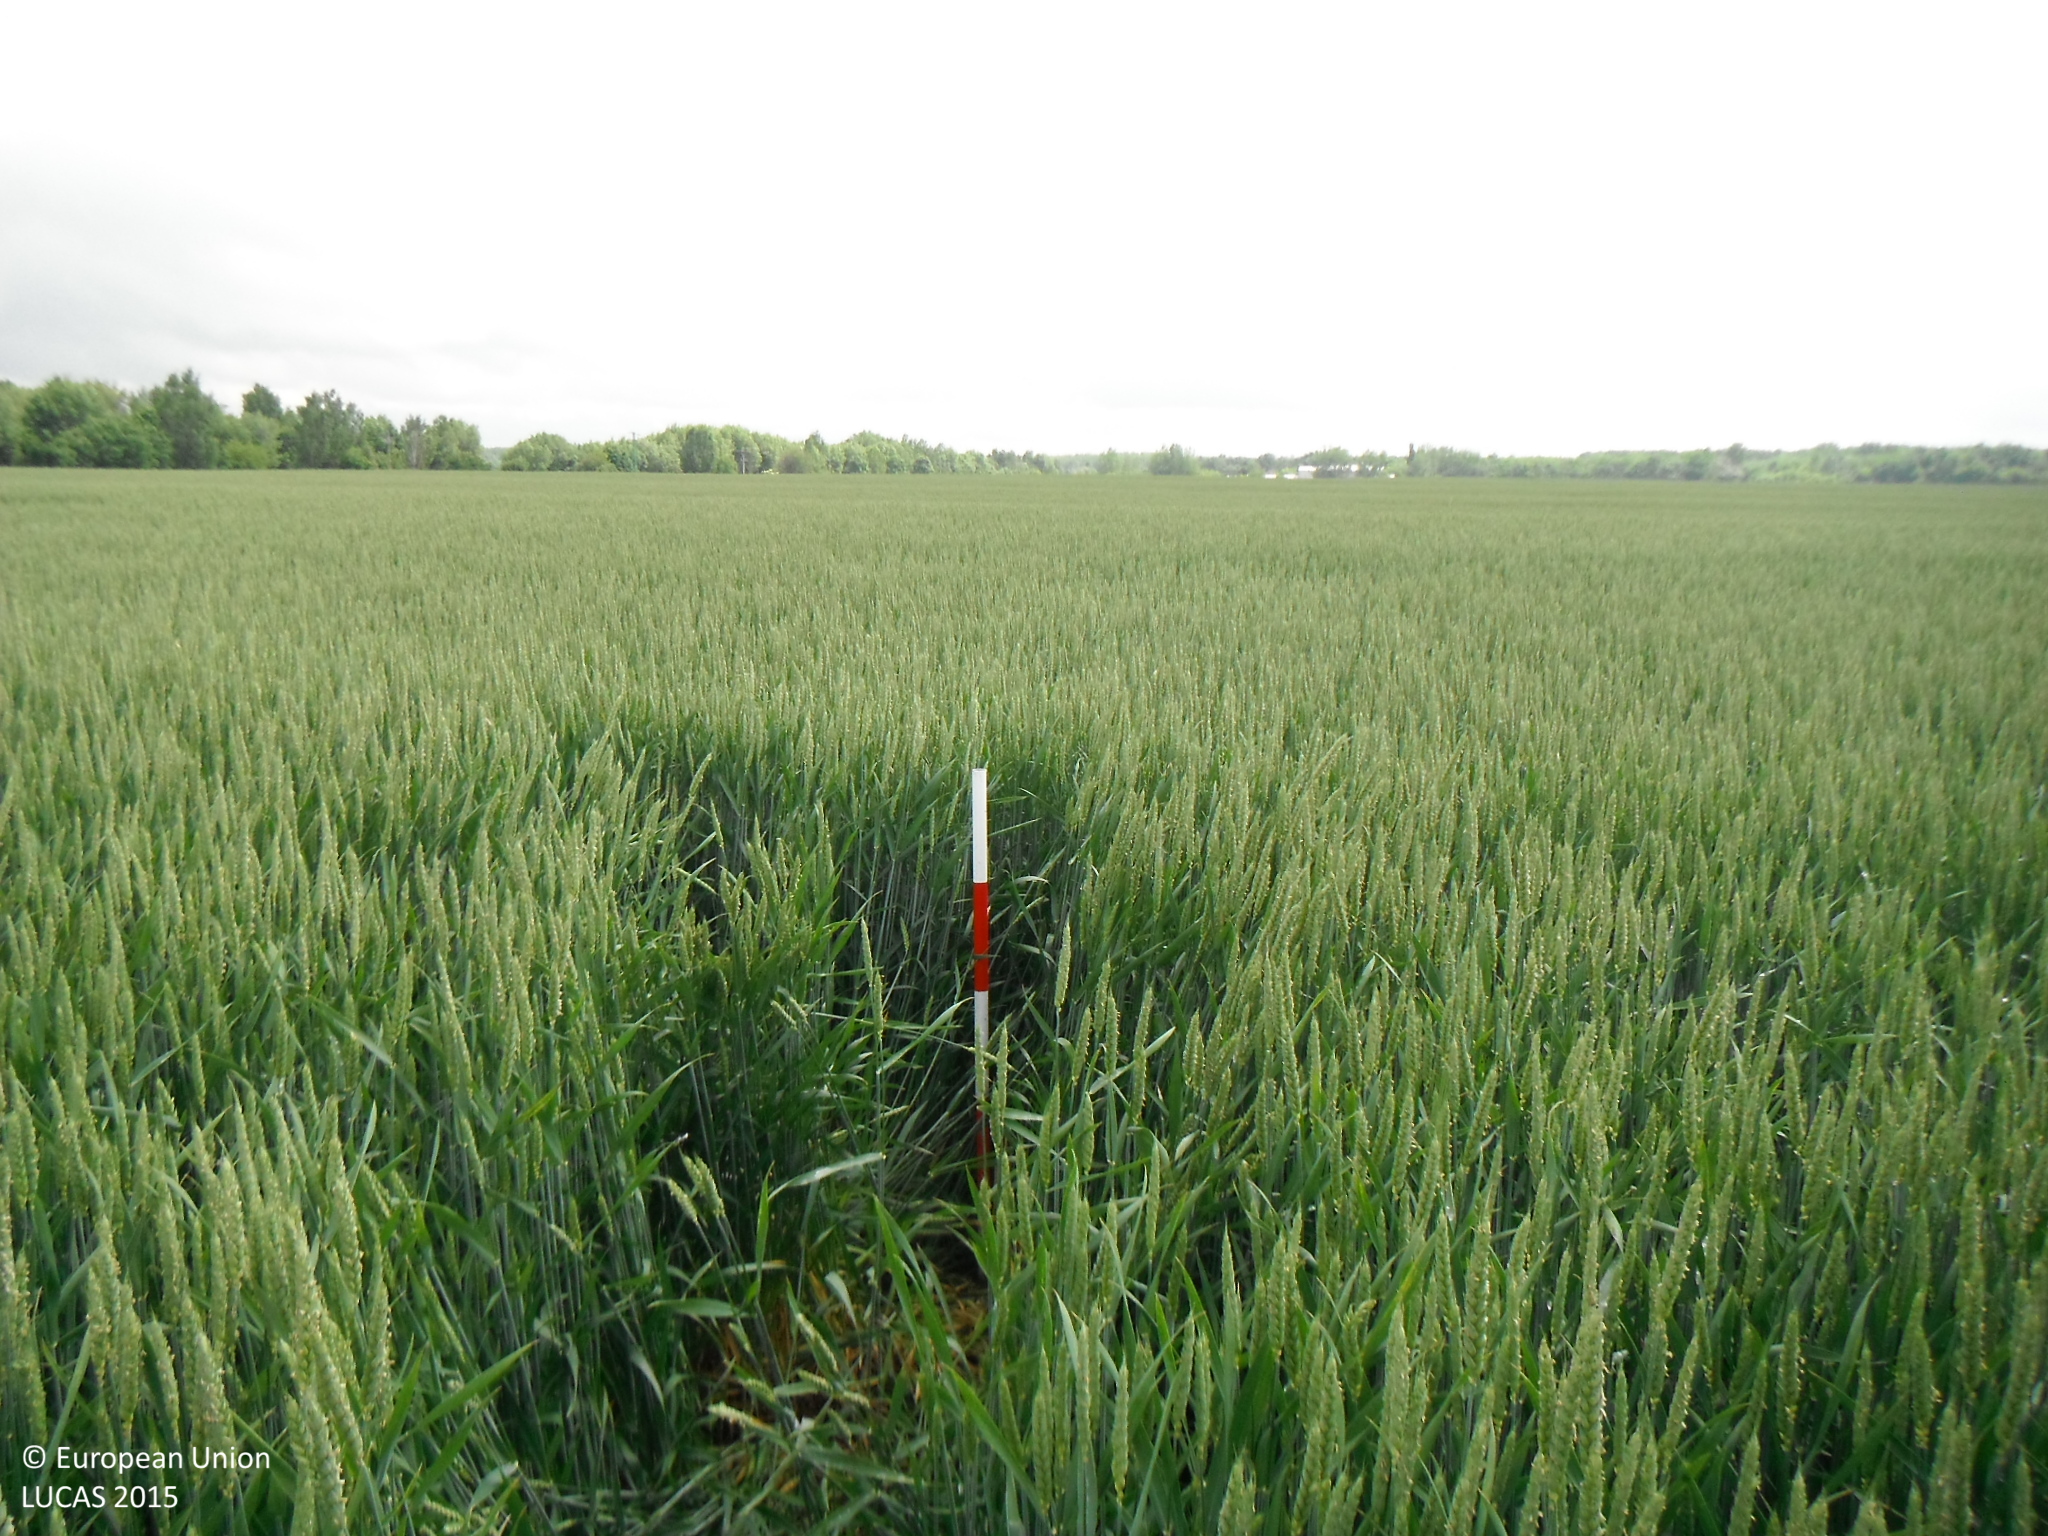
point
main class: Cropland
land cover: Common wheat
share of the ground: > 75 %
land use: Agriculture (excluding fallow land and kitchen gardens)
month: May
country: SK
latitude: 48.1528
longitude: 18.2003
